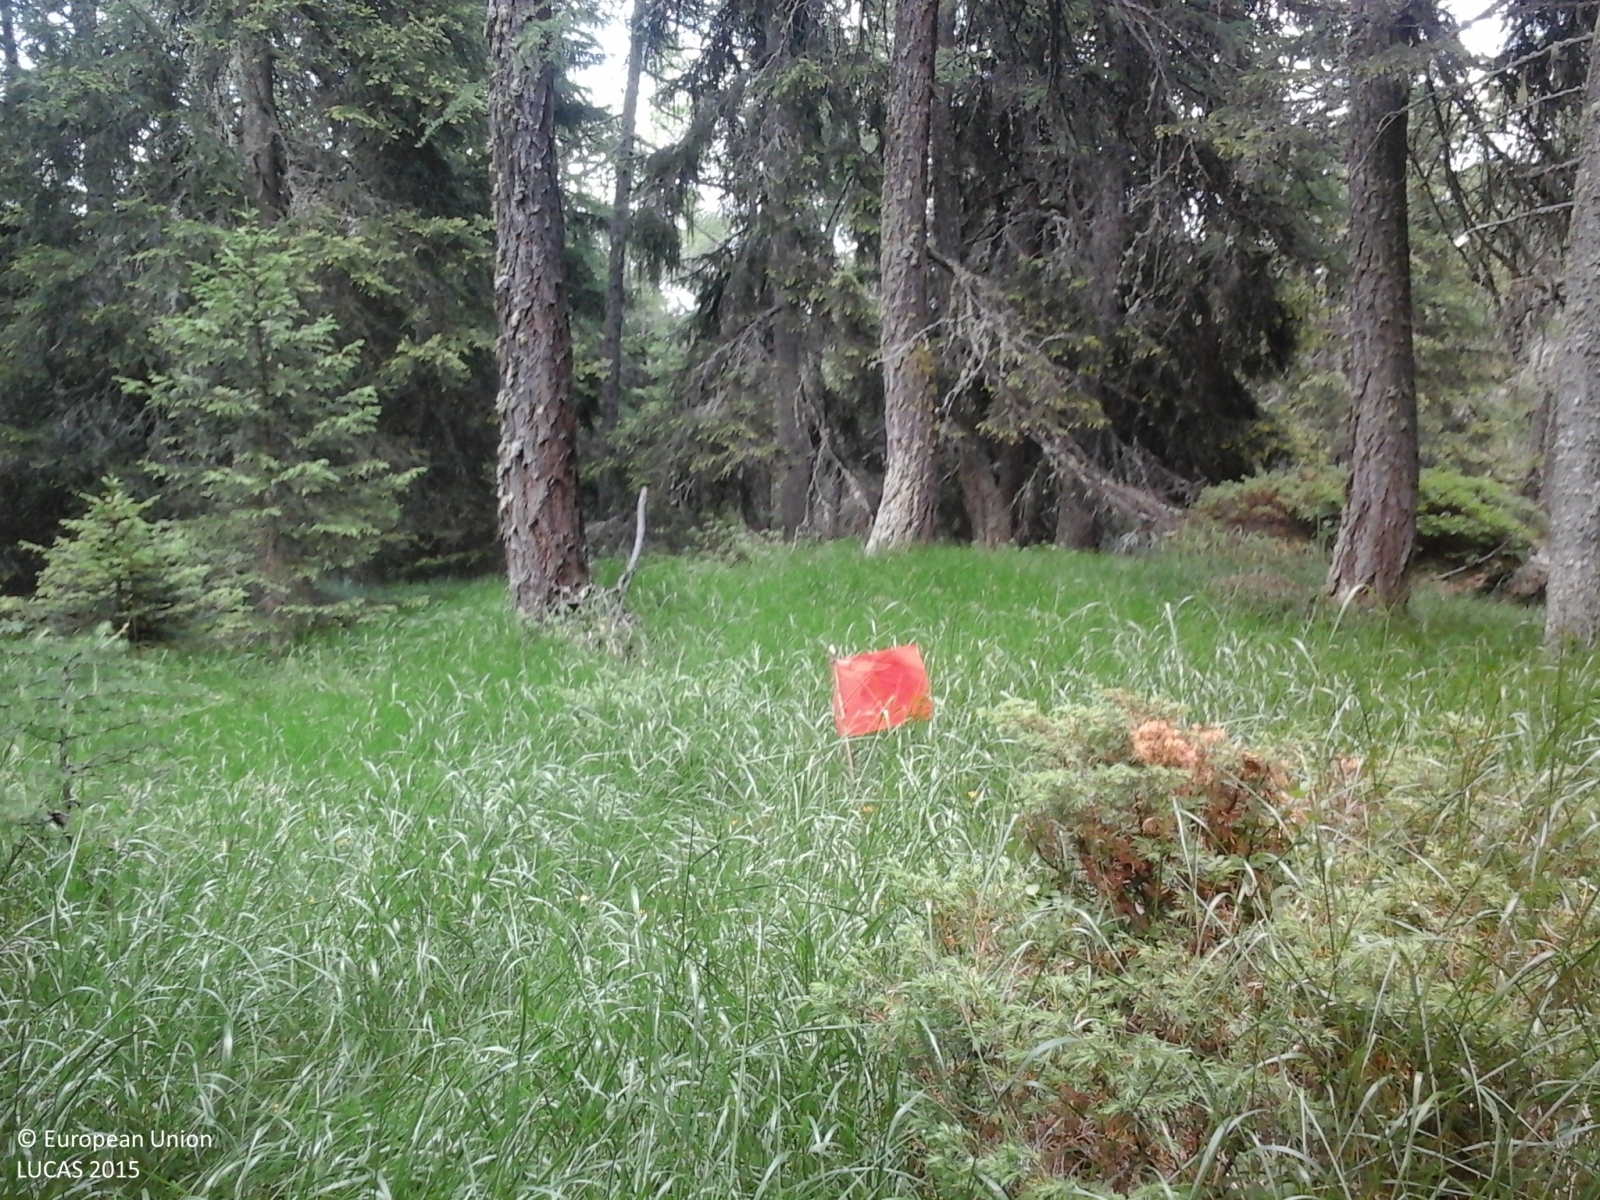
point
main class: Woodland
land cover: Other coniferous woodland
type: alpine coniferous forest
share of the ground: > 75 %
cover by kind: coniferous forest trees 100 %
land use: Forestry
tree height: > 5 m
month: July
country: IT
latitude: 45.8004
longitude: 7.5459
